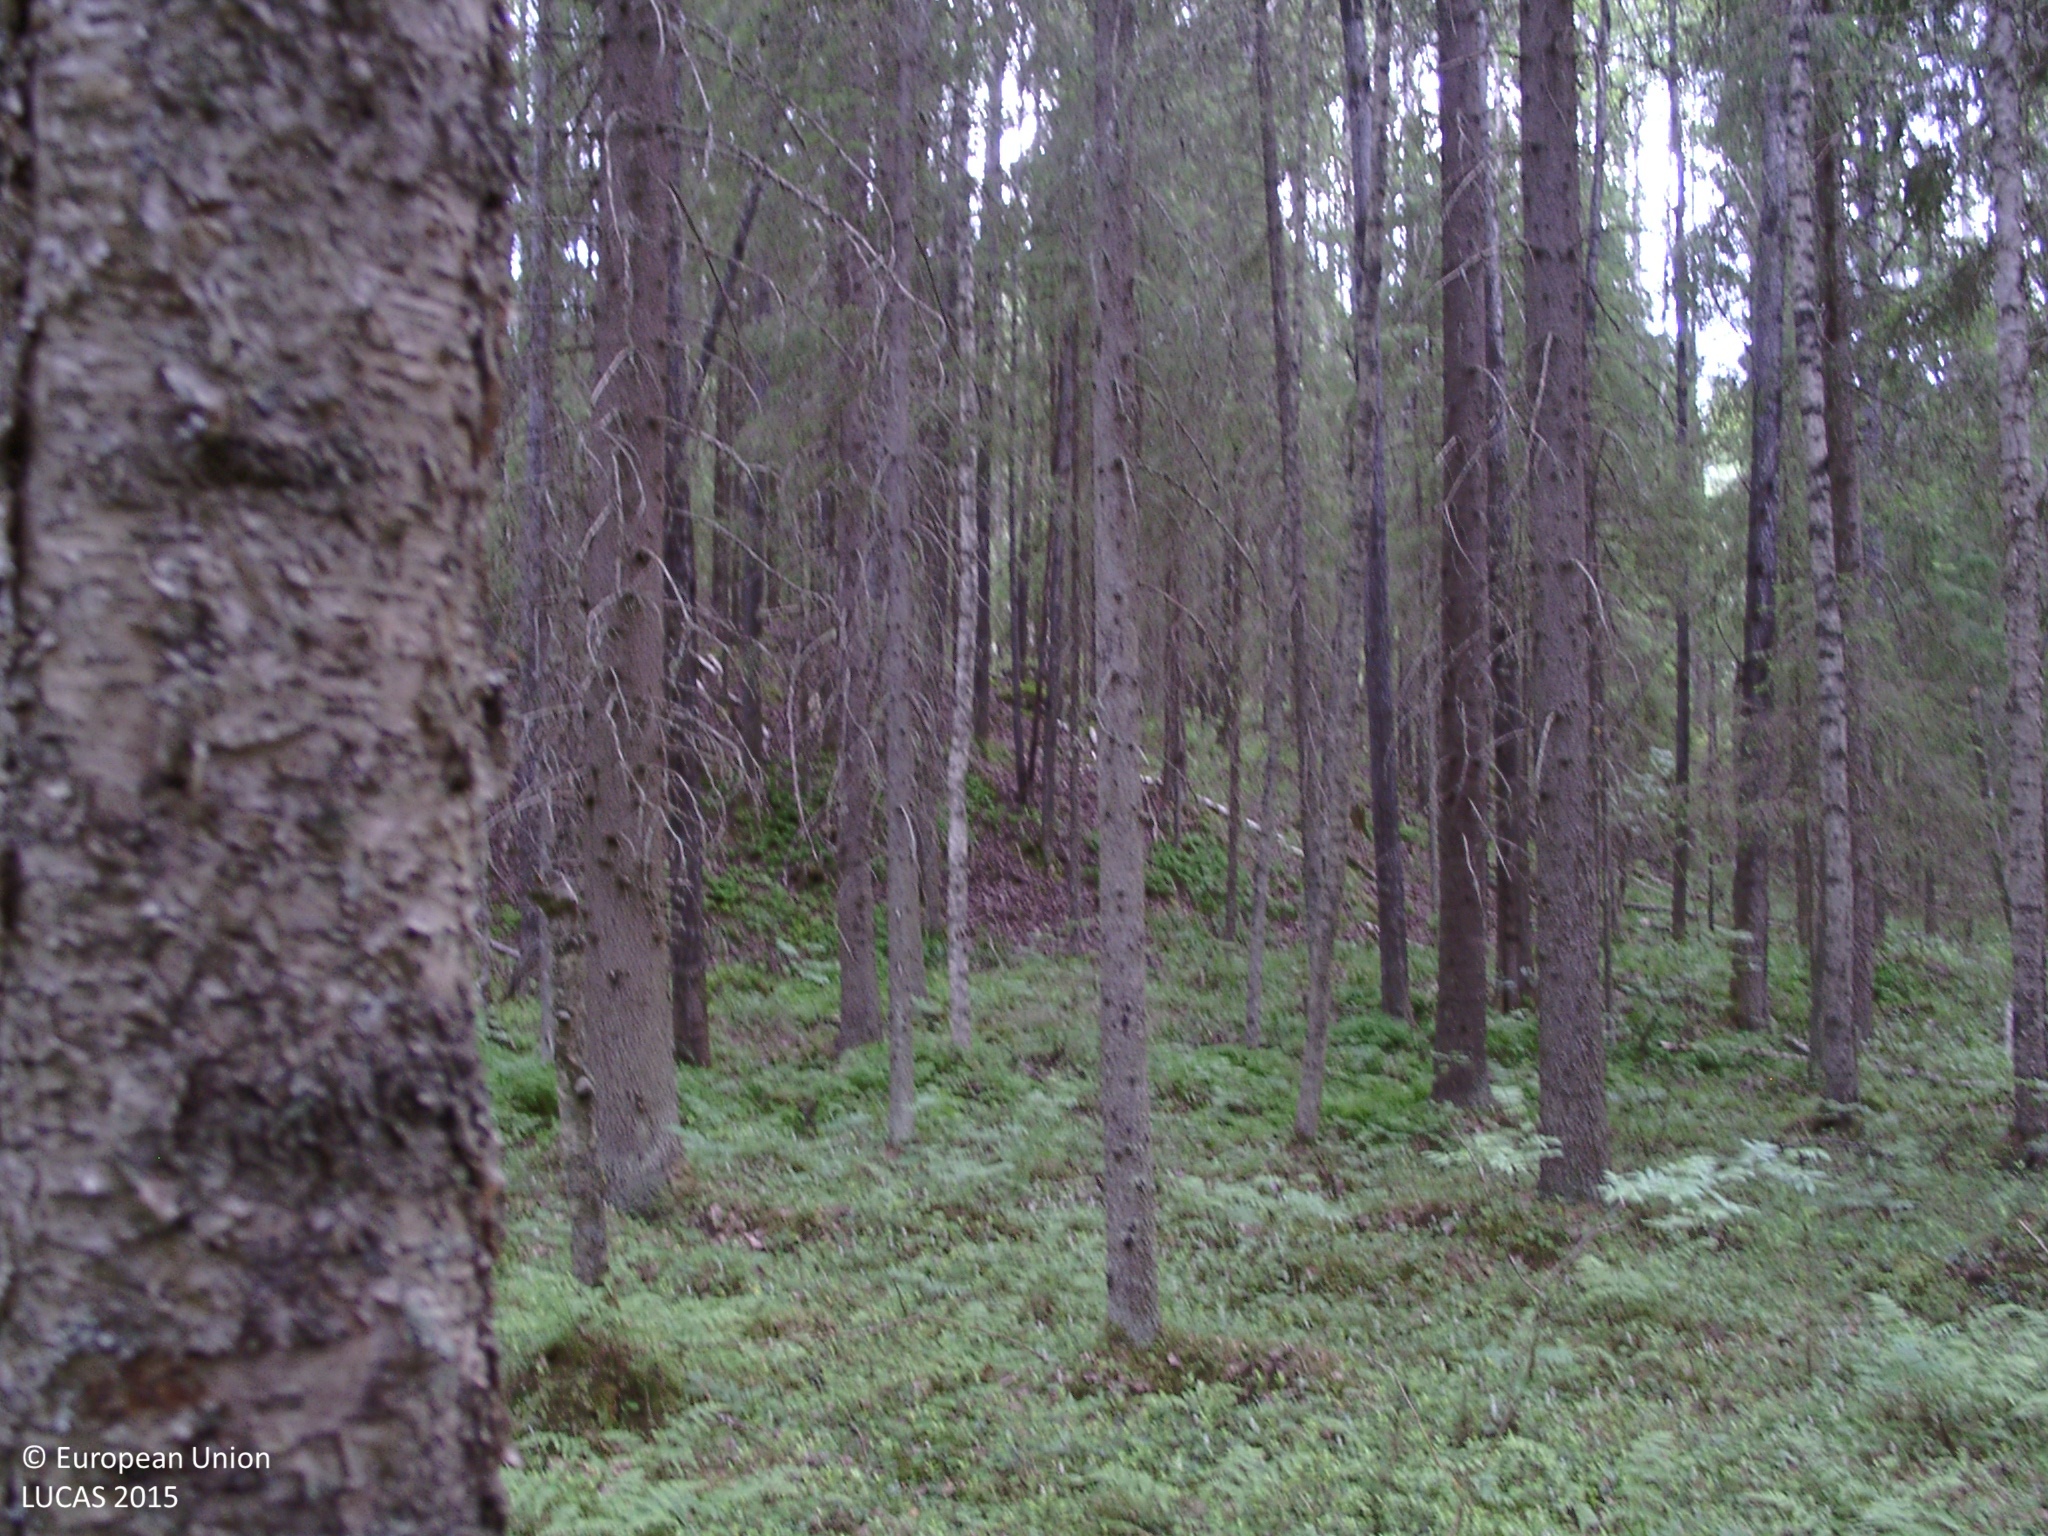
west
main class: Woodland
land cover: Spruce dominated coniferous woodland
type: boreal forest
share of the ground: > 75 %
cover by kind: coniferous forest trees 65 %, broadleaved forest trees 15 %, lichens and mosses 10 %, shrubs 5 %, herbaceous plants 5 %
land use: Semi-natural and natural areas not in use
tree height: > 5 m
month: June
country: FI
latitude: 62.0451
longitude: 25.1180
